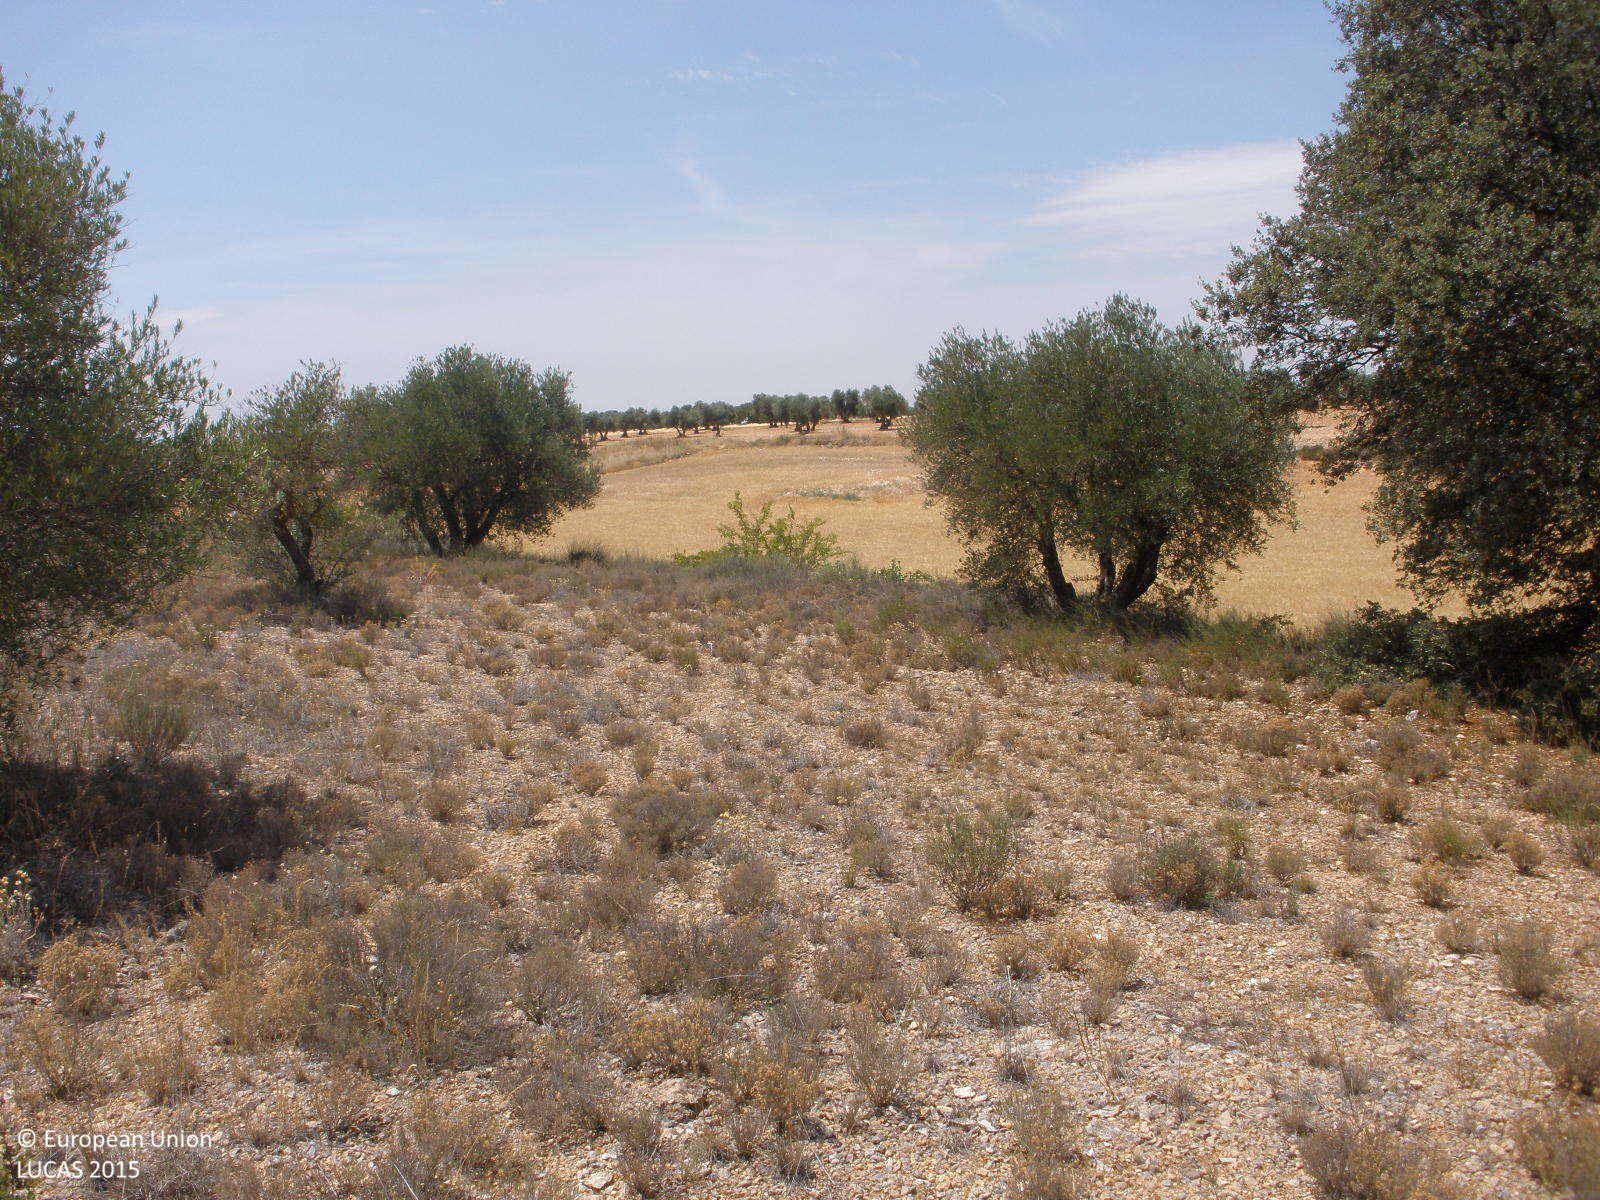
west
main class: Cropland
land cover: Olive groves
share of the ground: 25 - 50 %
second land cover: Shrubland without tree cover
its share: 50 - 75 %
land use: Agriculture (excluding fallow land and kitchen gardens)
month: July
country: ES
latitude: 39.8593
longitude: -3.2452
